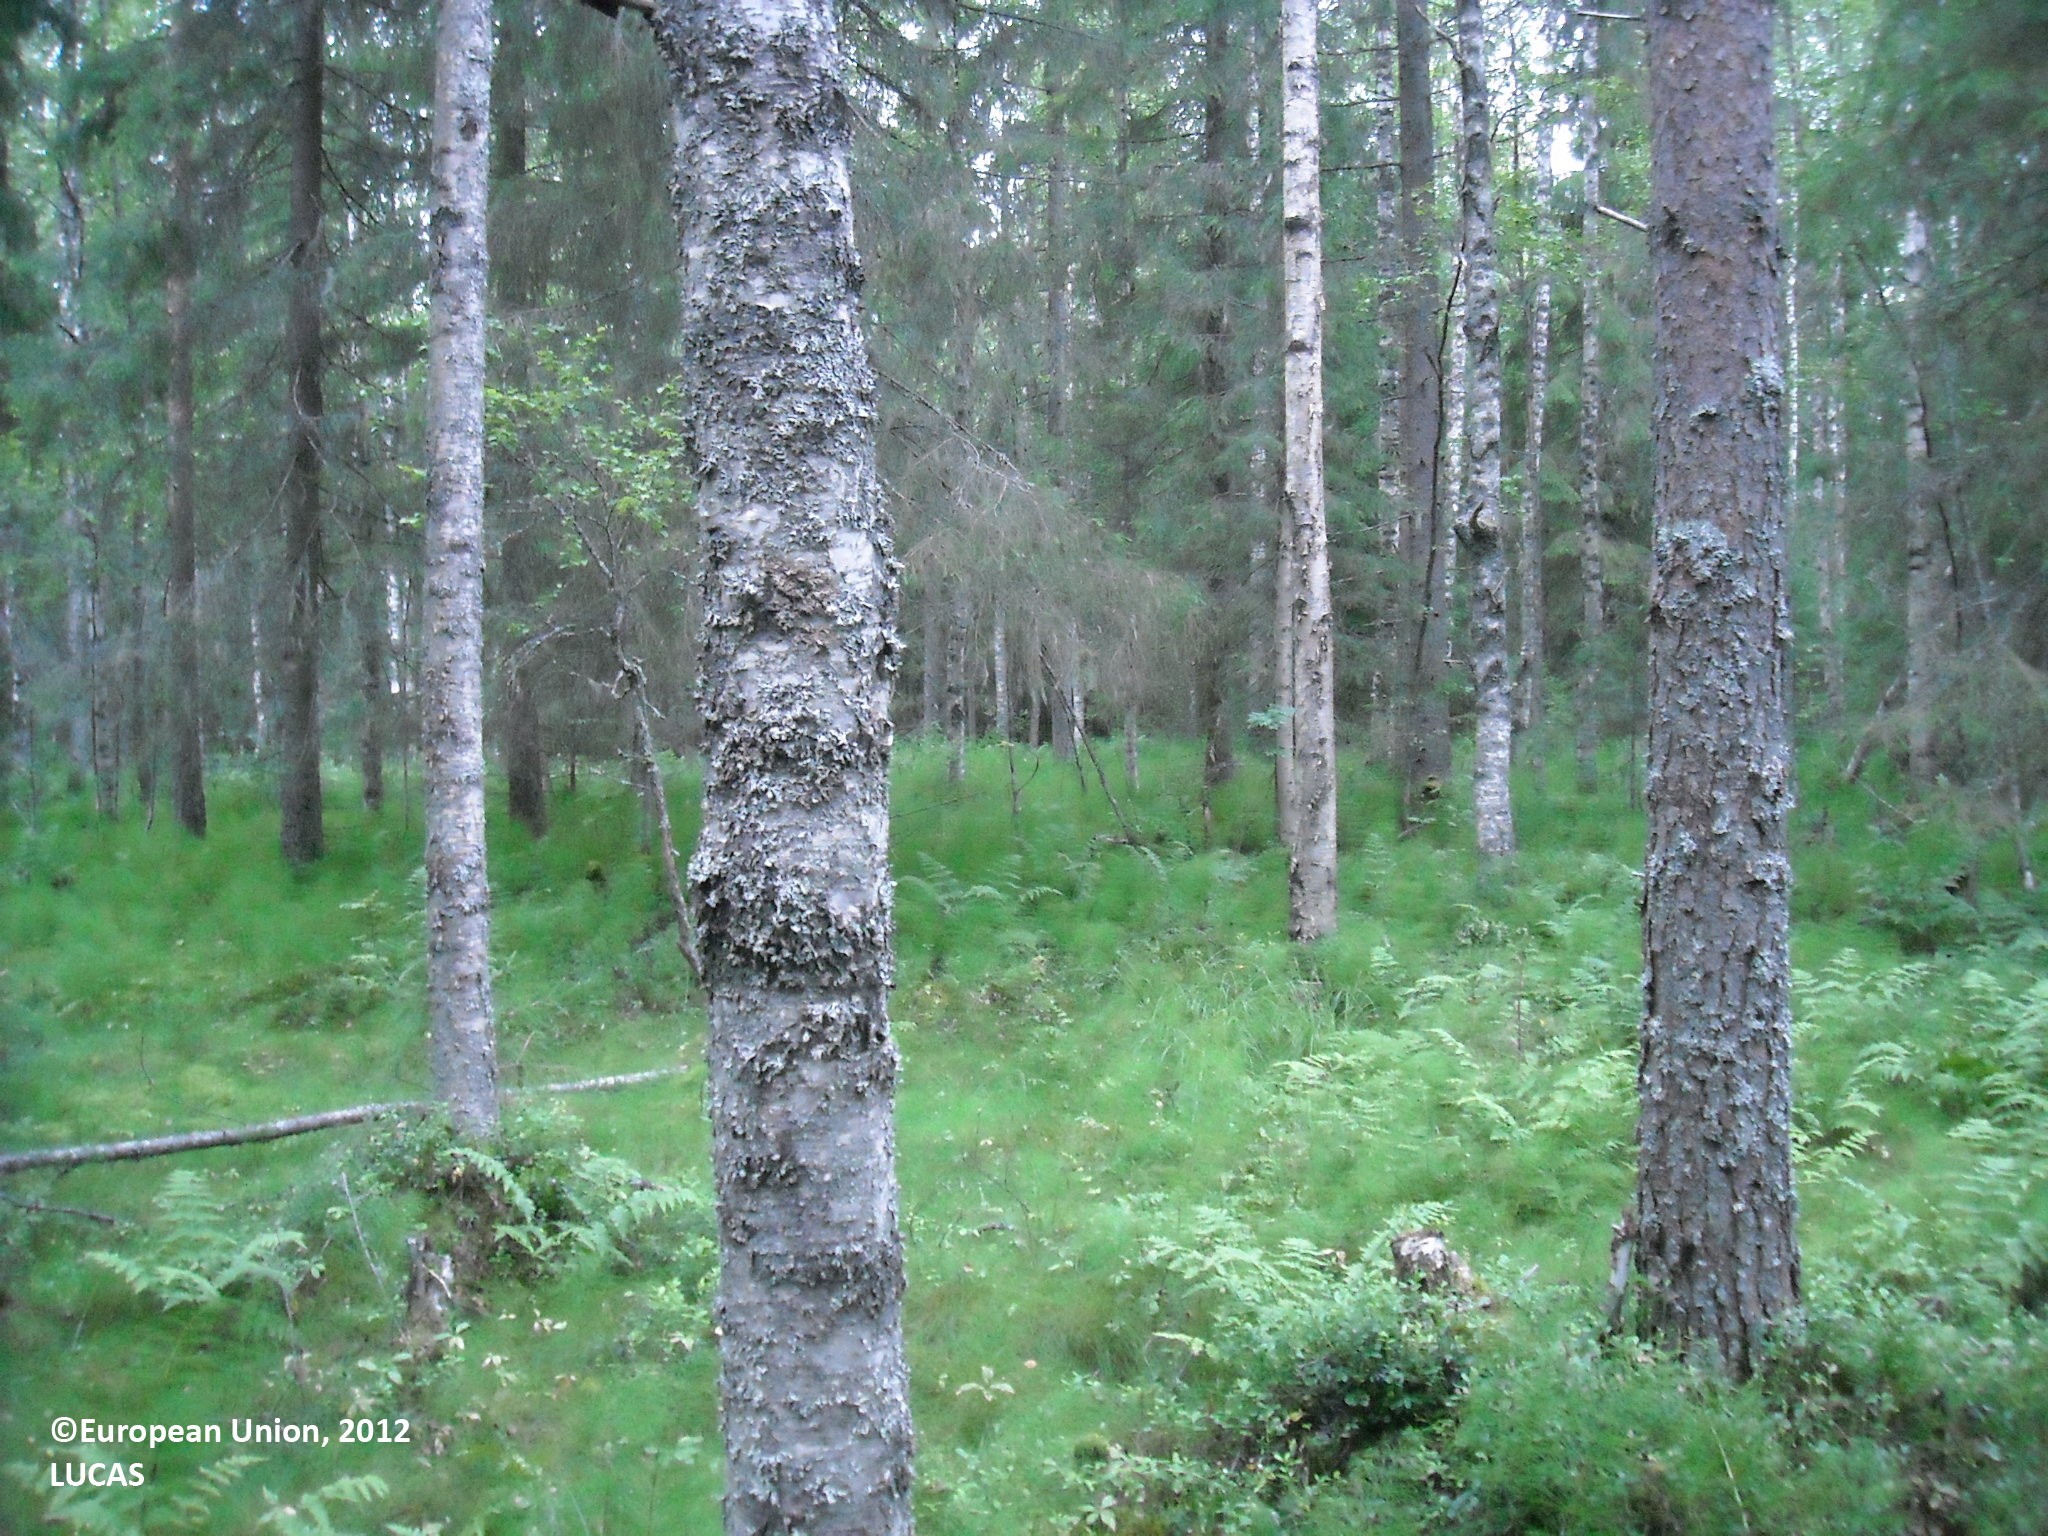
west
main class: Woodland
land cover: Other mixed woodland
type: boreal forest
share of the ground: > 75 %
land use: Forestry
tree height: > 5 m
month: July
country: FI
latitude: 64.8785
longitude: 26.6867
